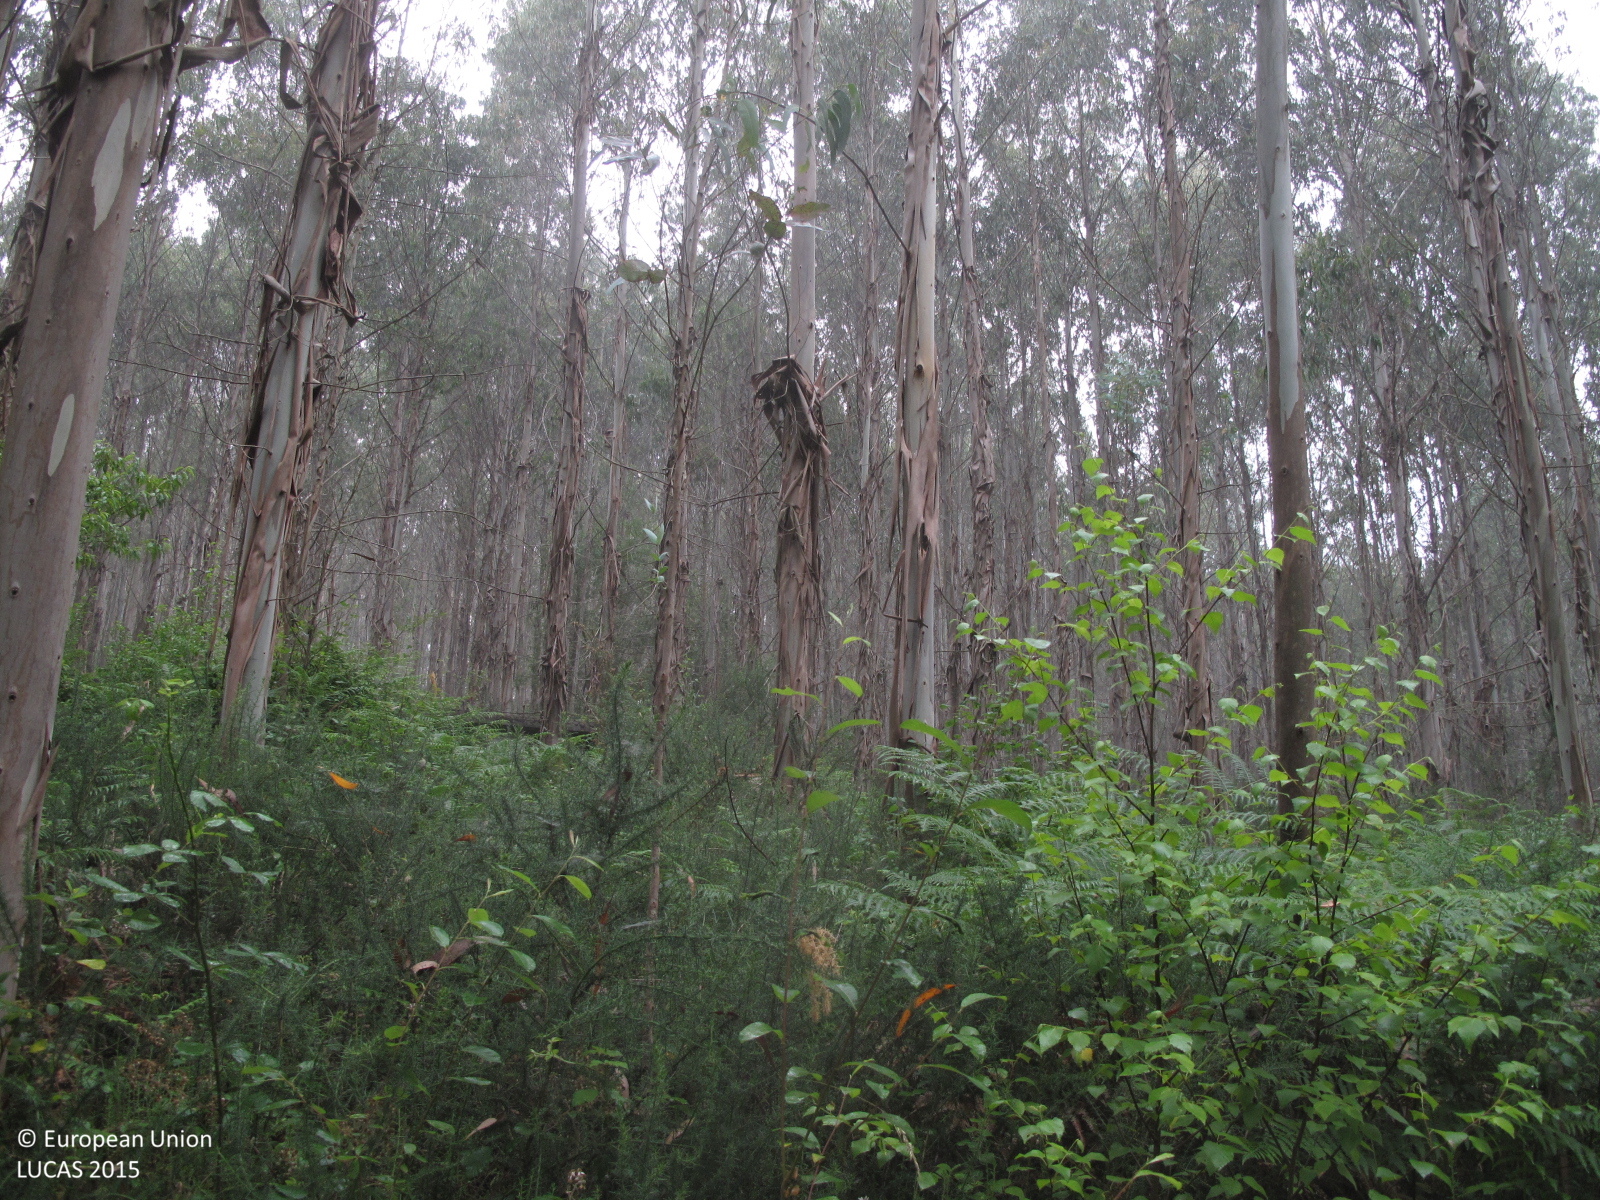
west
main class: Woodland
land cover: Broadleaved woodland
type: exotic forest
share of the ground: 50 - 75 %
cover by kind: broadleaved forest trees 70 %, shrubs 20 %, herbaceous plants 10 %
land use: Forestry
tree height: > 5 m
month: June
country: ES
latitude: 43.1992
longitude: -8.2268
